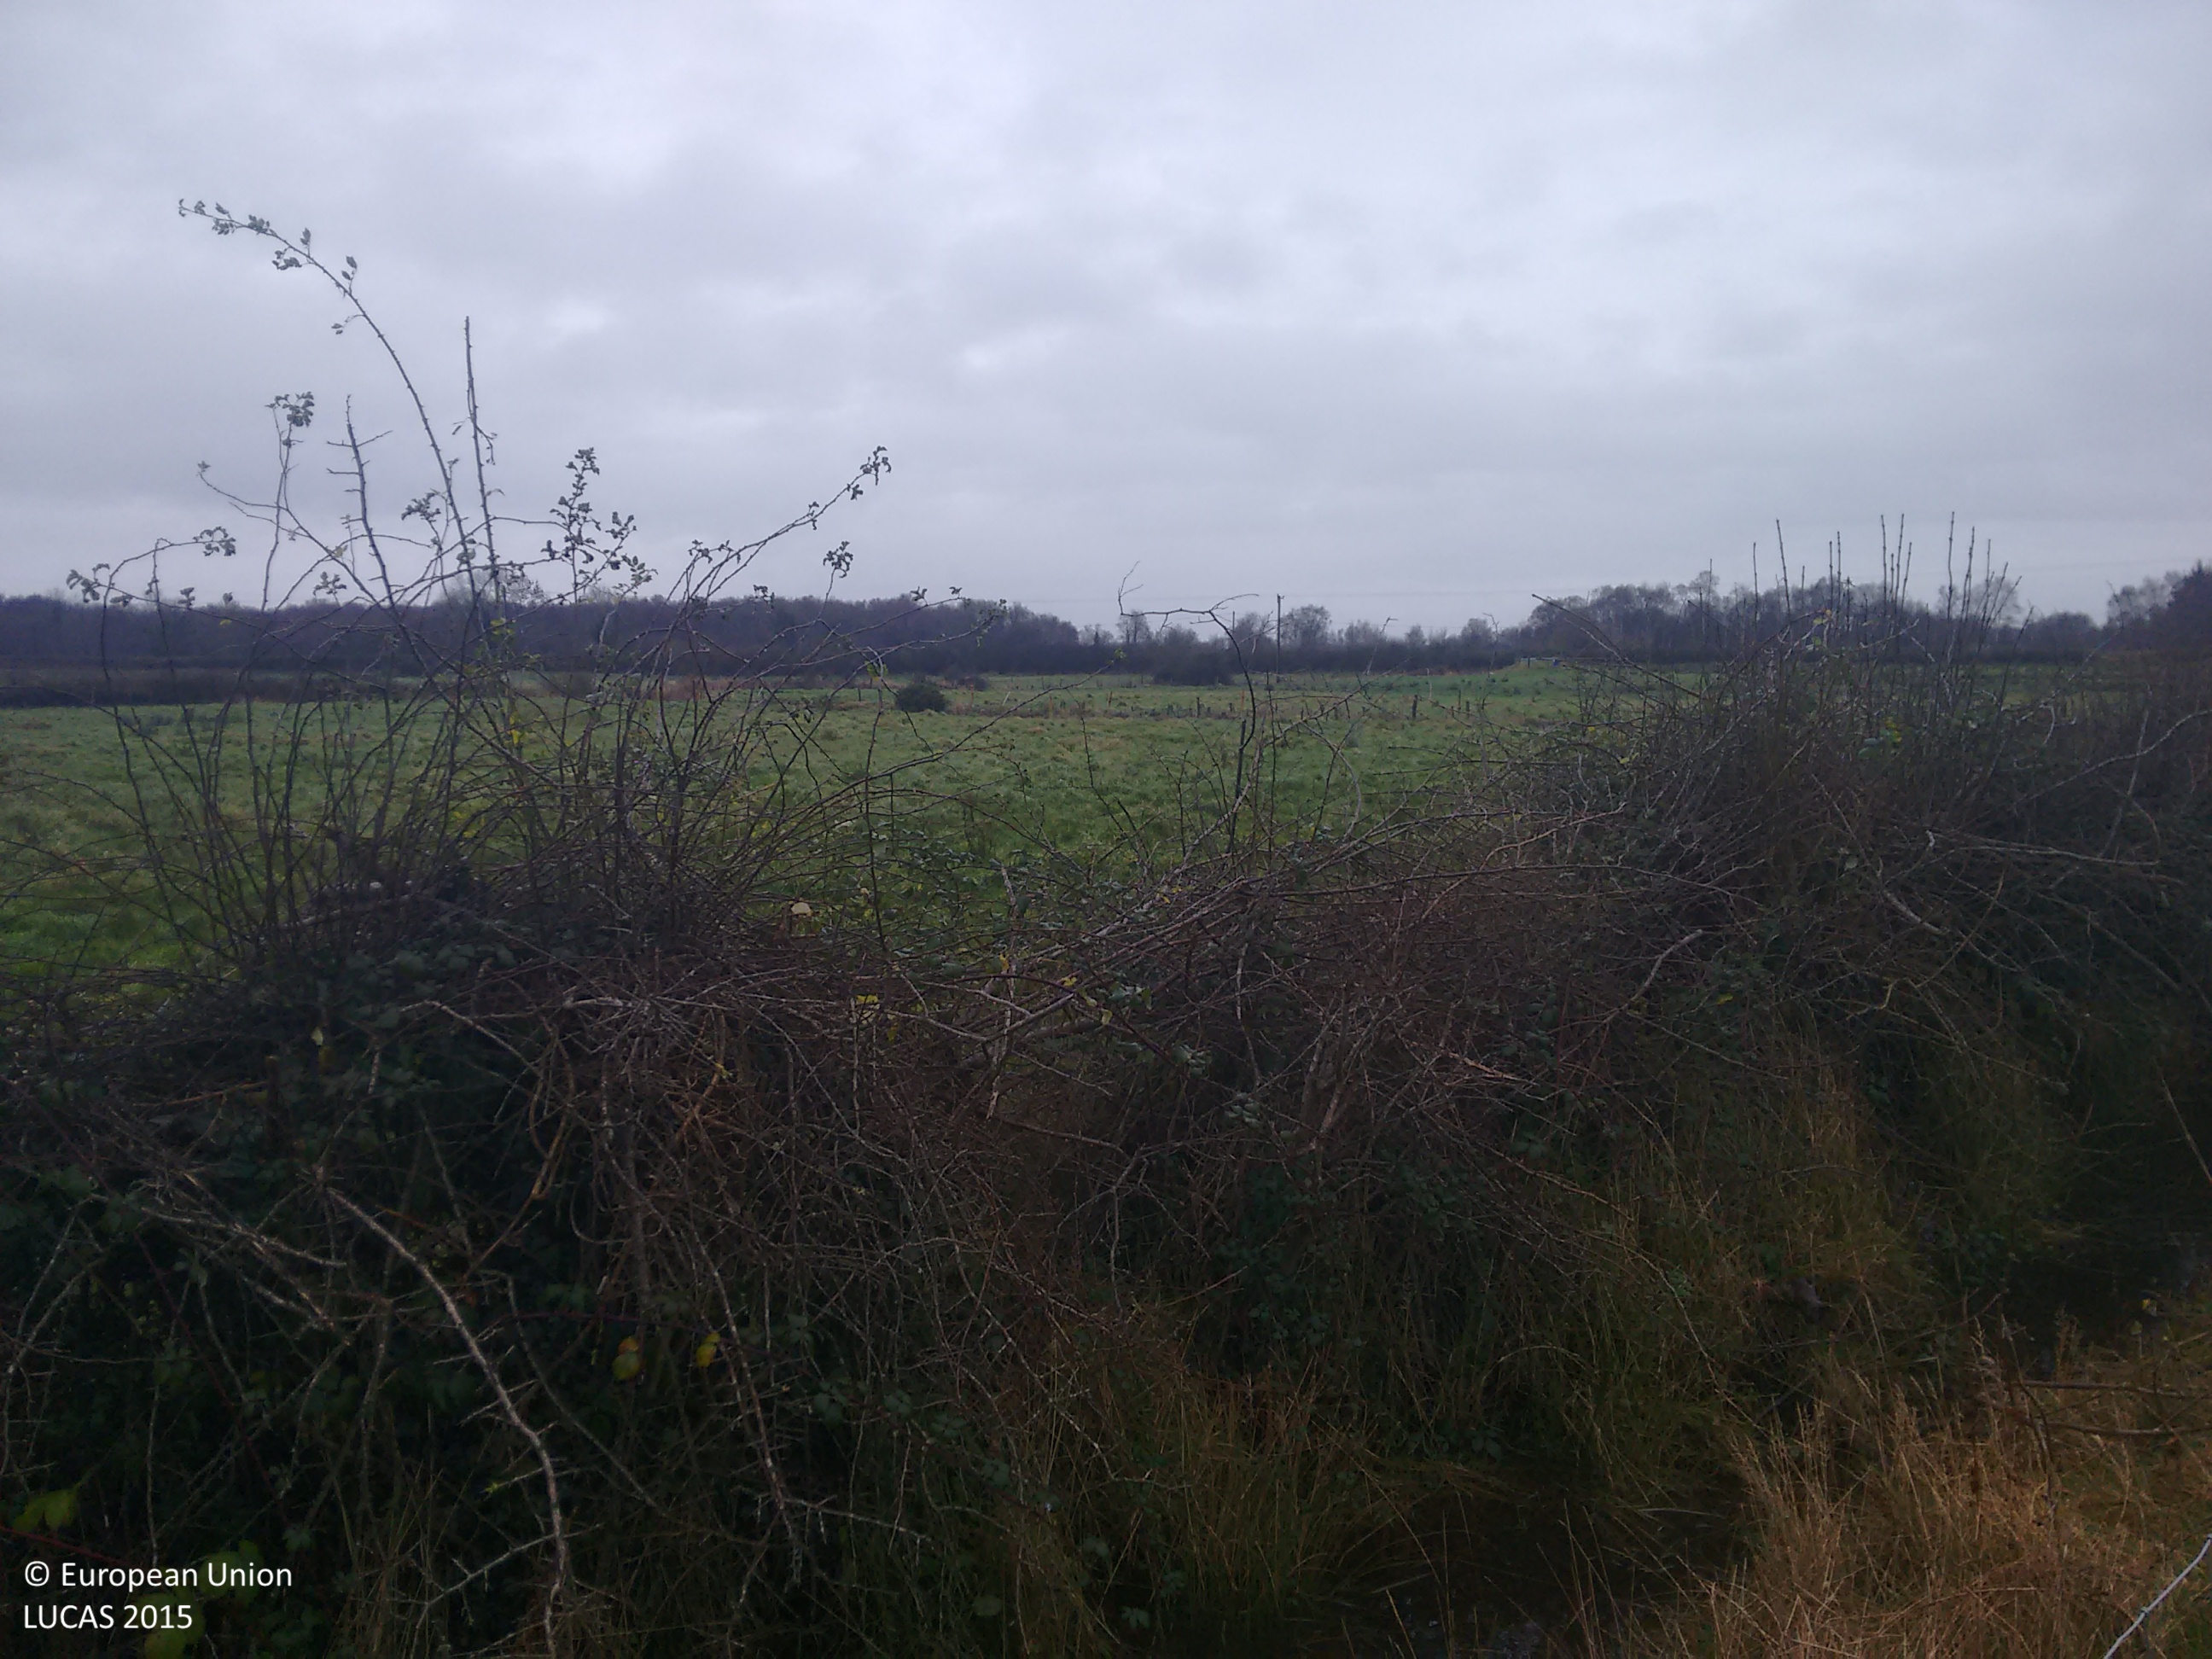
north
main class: Grassland
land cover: Grassland without tree/shrub cover
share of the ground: > 75 %
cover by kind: herbaceous plants 100 %
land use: Agriculture (excluding fallow land and kitchen gardens)
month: December
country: IE
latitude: 53.5847
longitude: -7.8900
